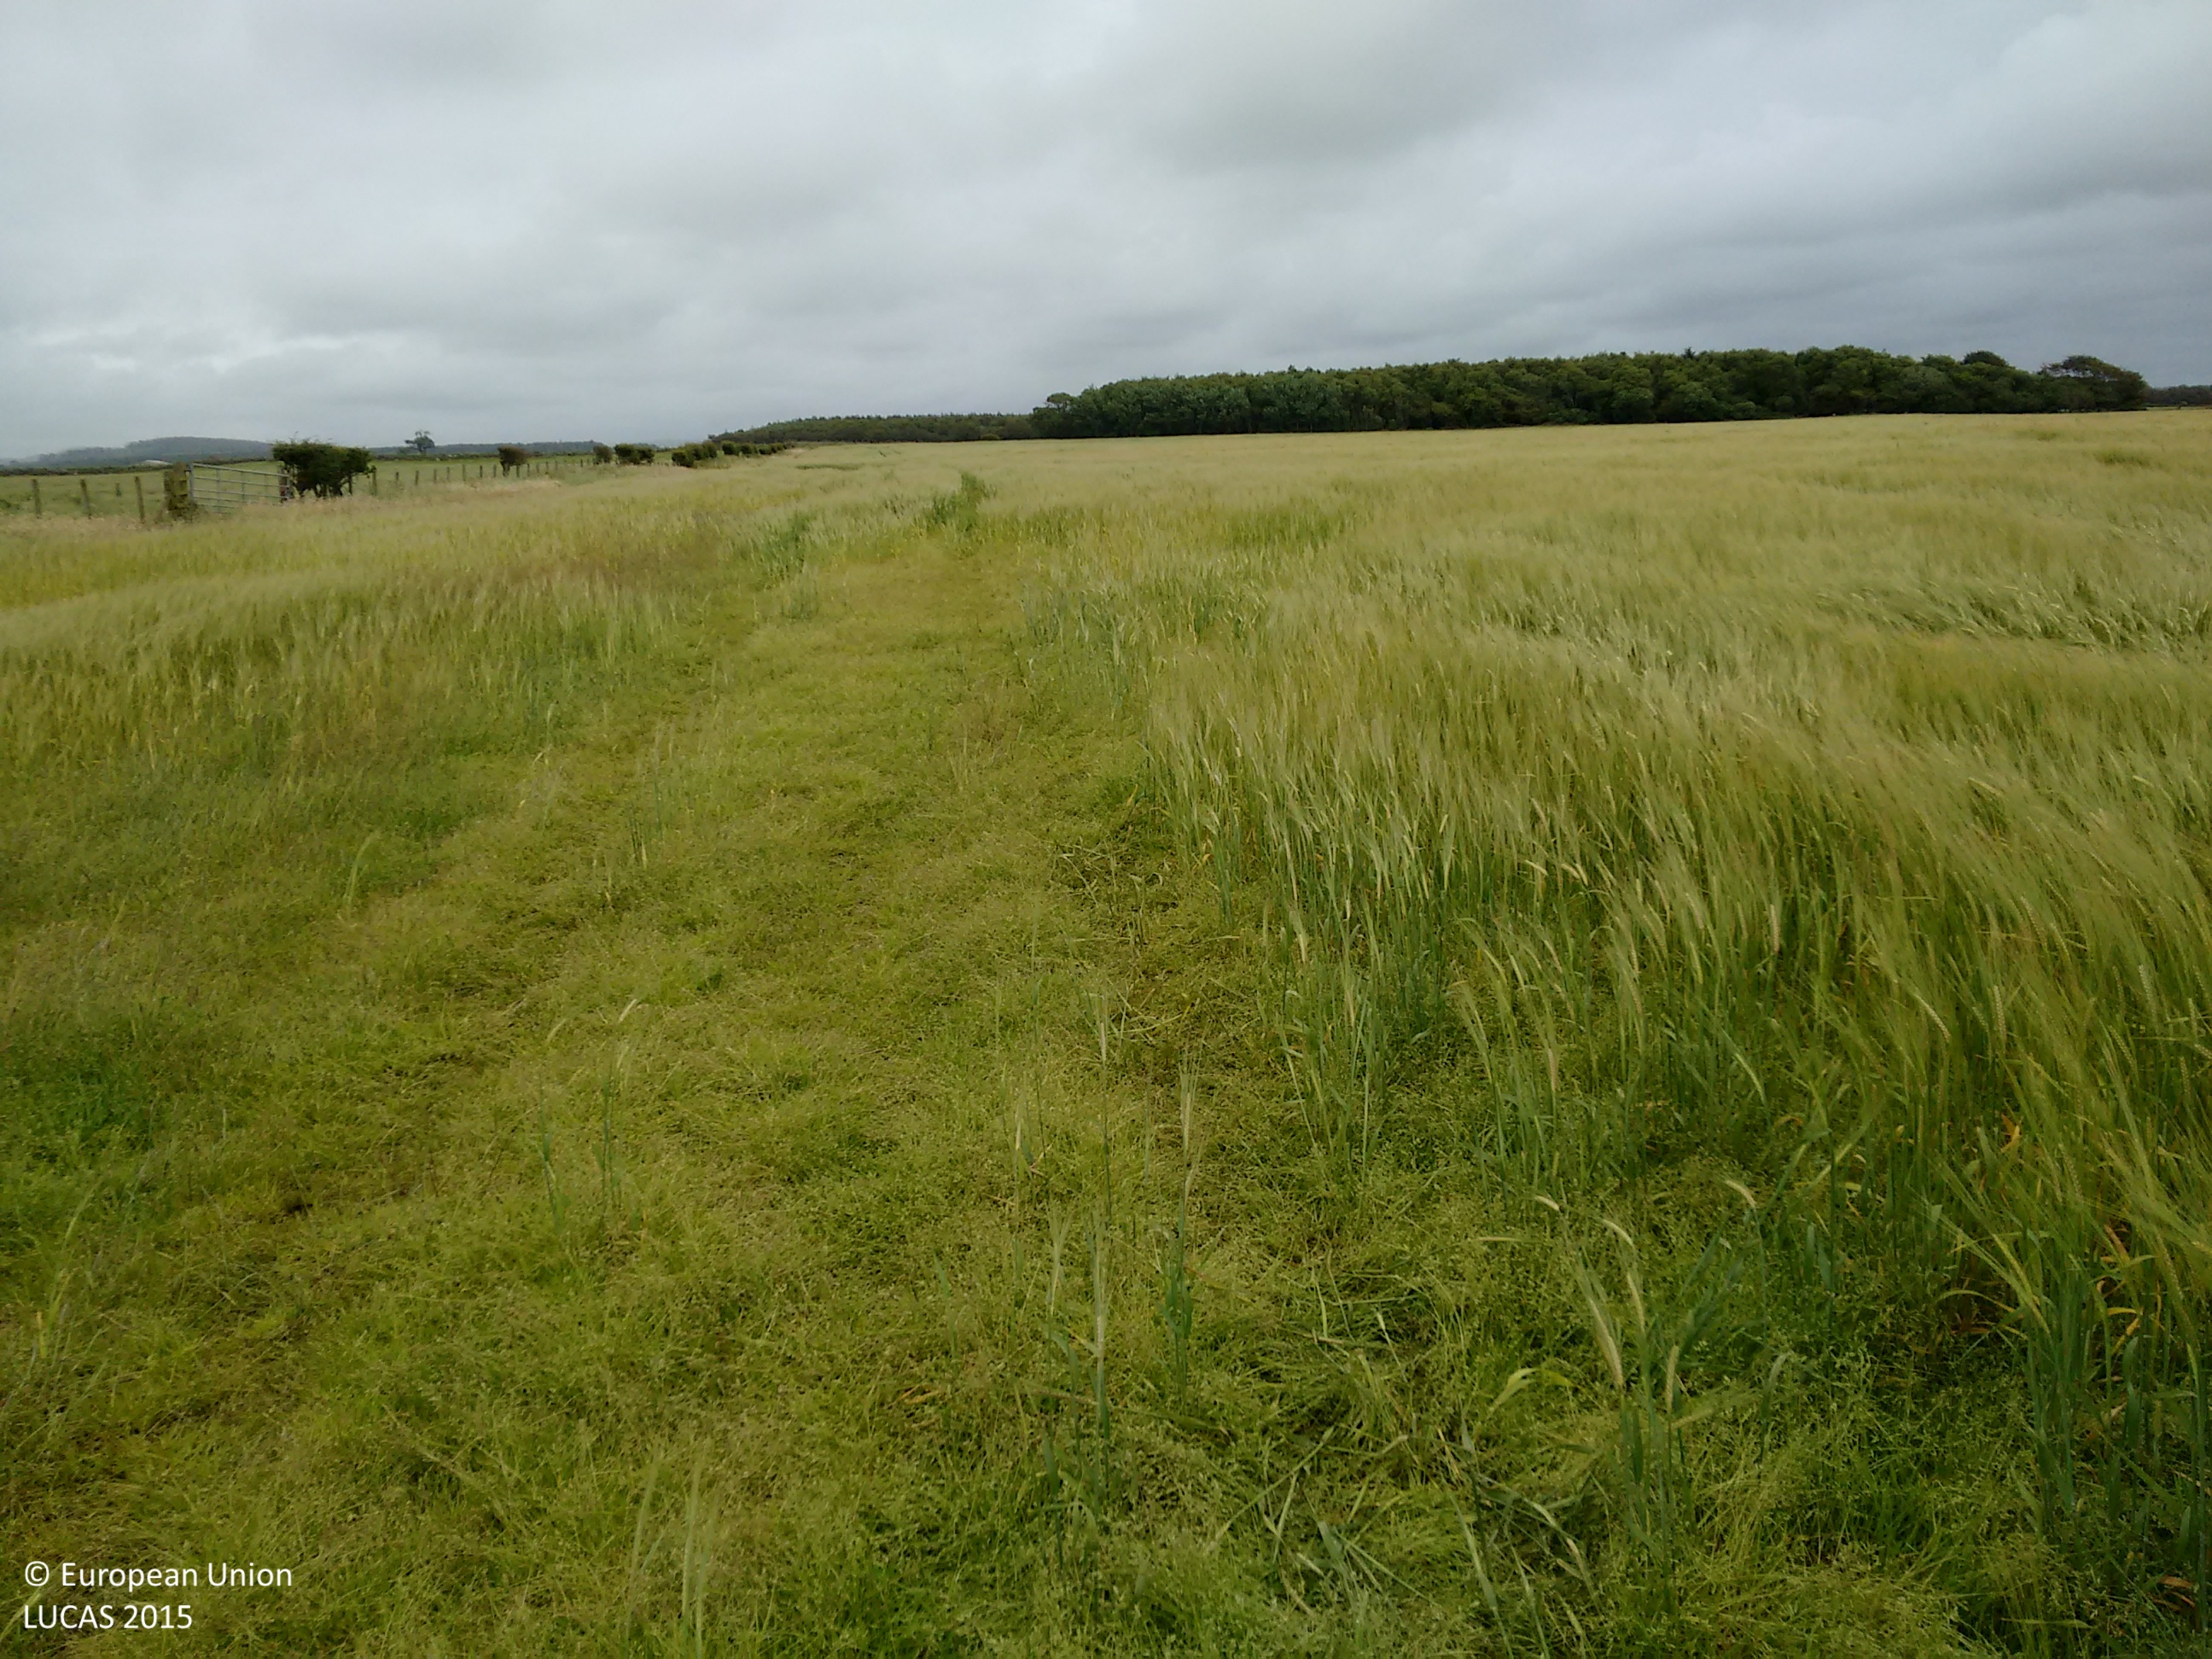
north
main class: Cropland
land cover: Barley
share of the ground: > 75 %
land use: Agriculture (excluding fallow land and kitchen gardens)
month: July
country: GB
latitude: 54.9968
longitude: -3.3172
